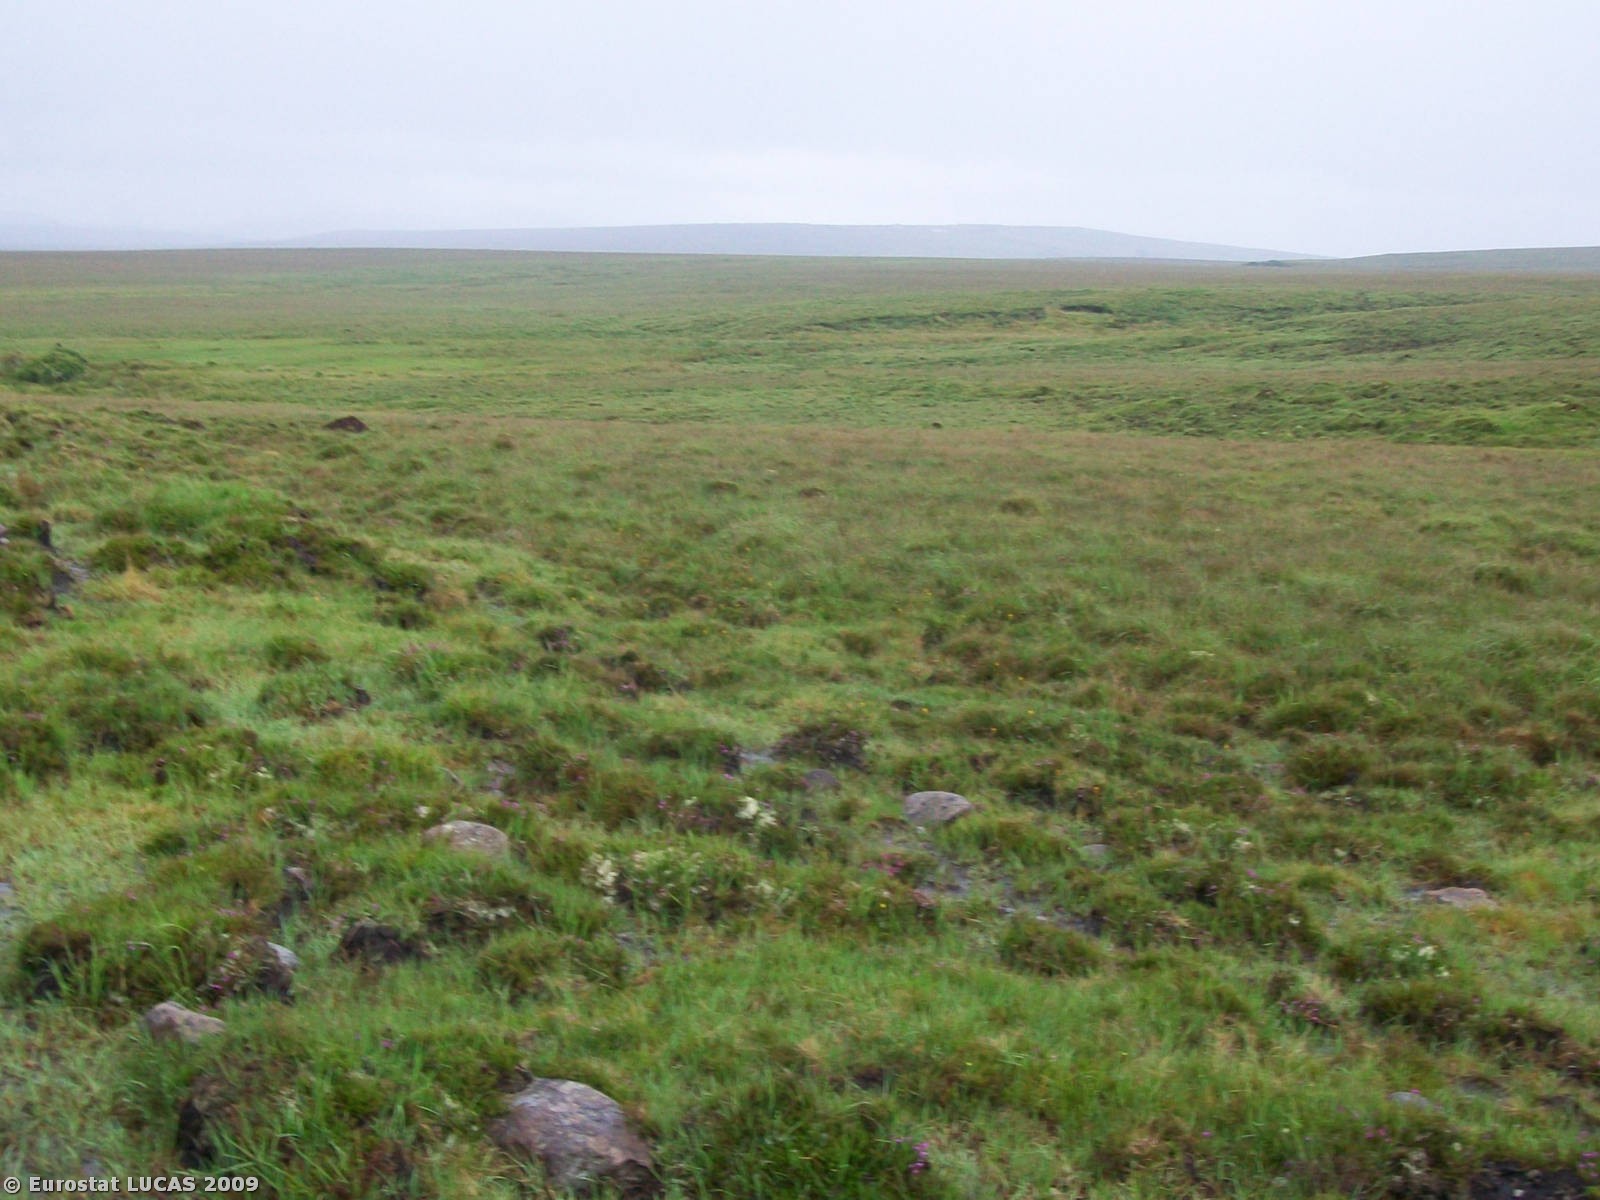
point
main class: Wetlands
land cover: Peatbogs
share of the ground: > 75 %
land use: Unused
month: July
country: IE
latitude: 54.0078
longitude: -9.7901
